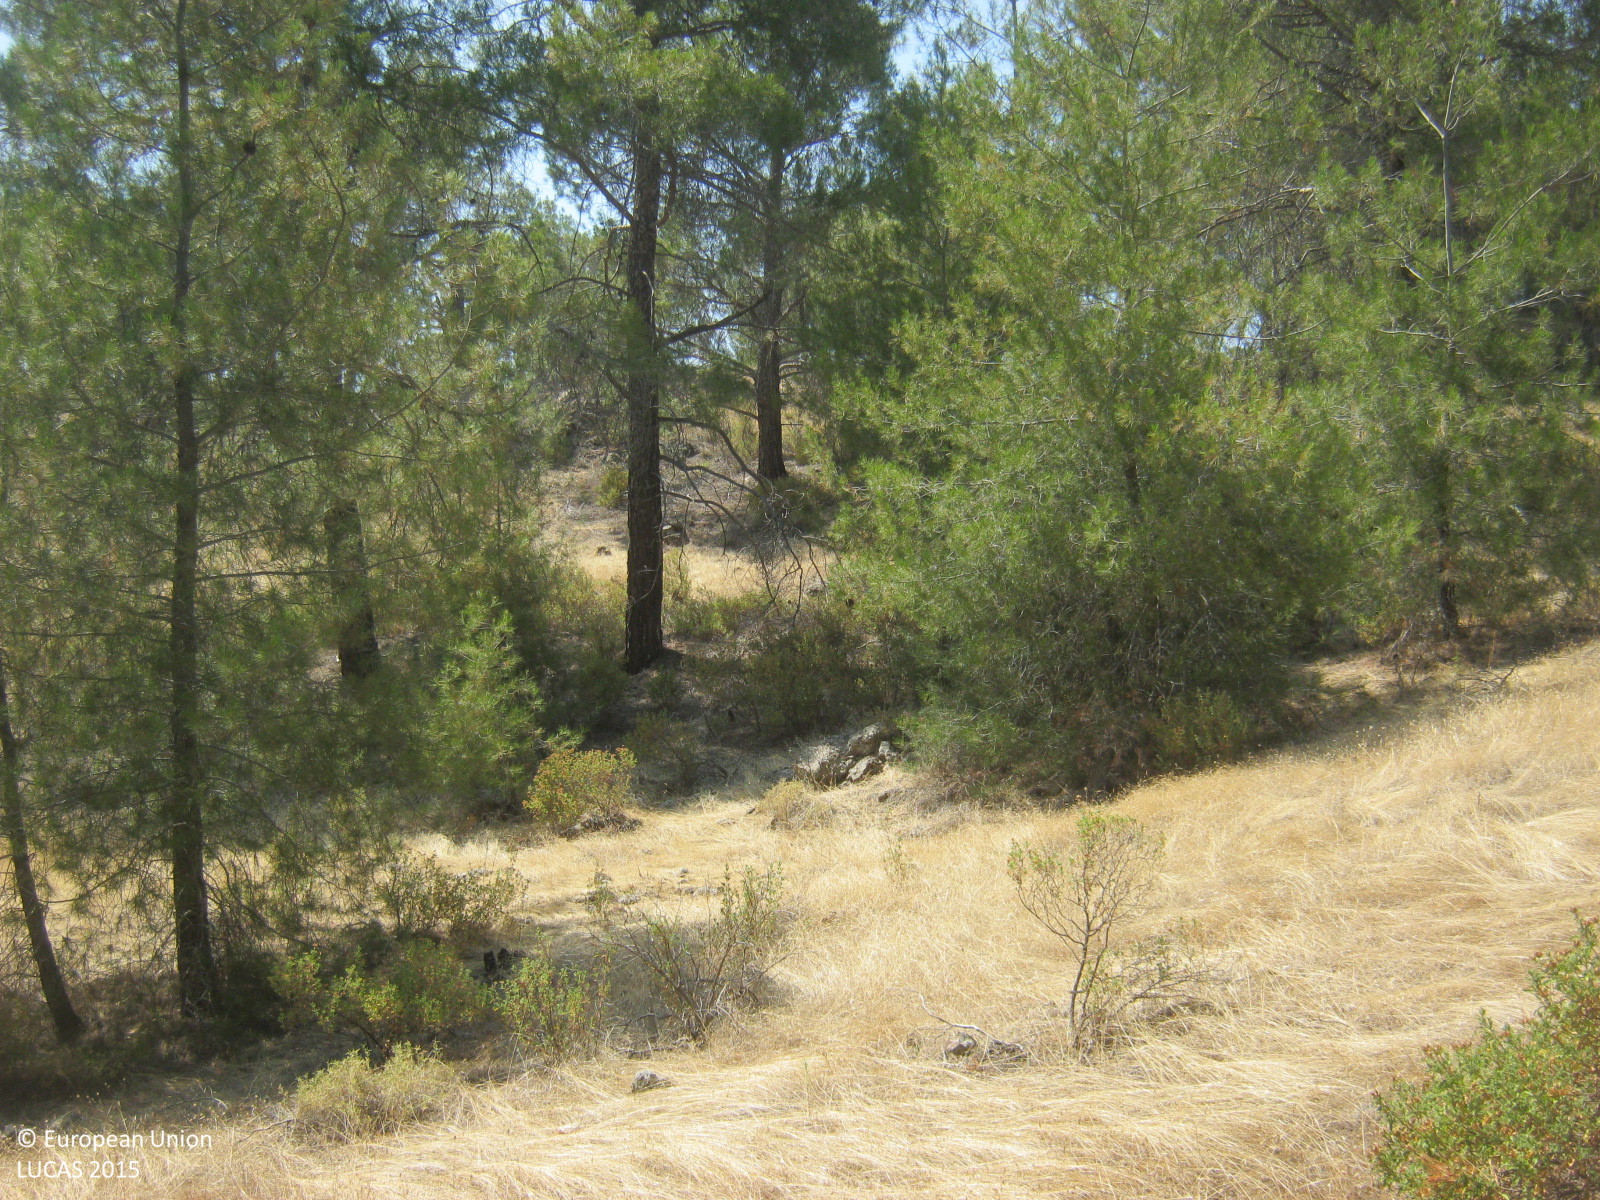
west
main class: Woodland
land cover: Pine dominated coniferous woodland
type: coniferous forest of the mediterranean region
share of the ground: 50 - 75 %
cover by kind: coniferous forest trees 70 %, shrubs 20 %, unconsolidated bare surface 10 %
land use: Forestry
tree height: > 5 m
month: June
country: CY
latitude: 35.0033
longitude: 33.1346
